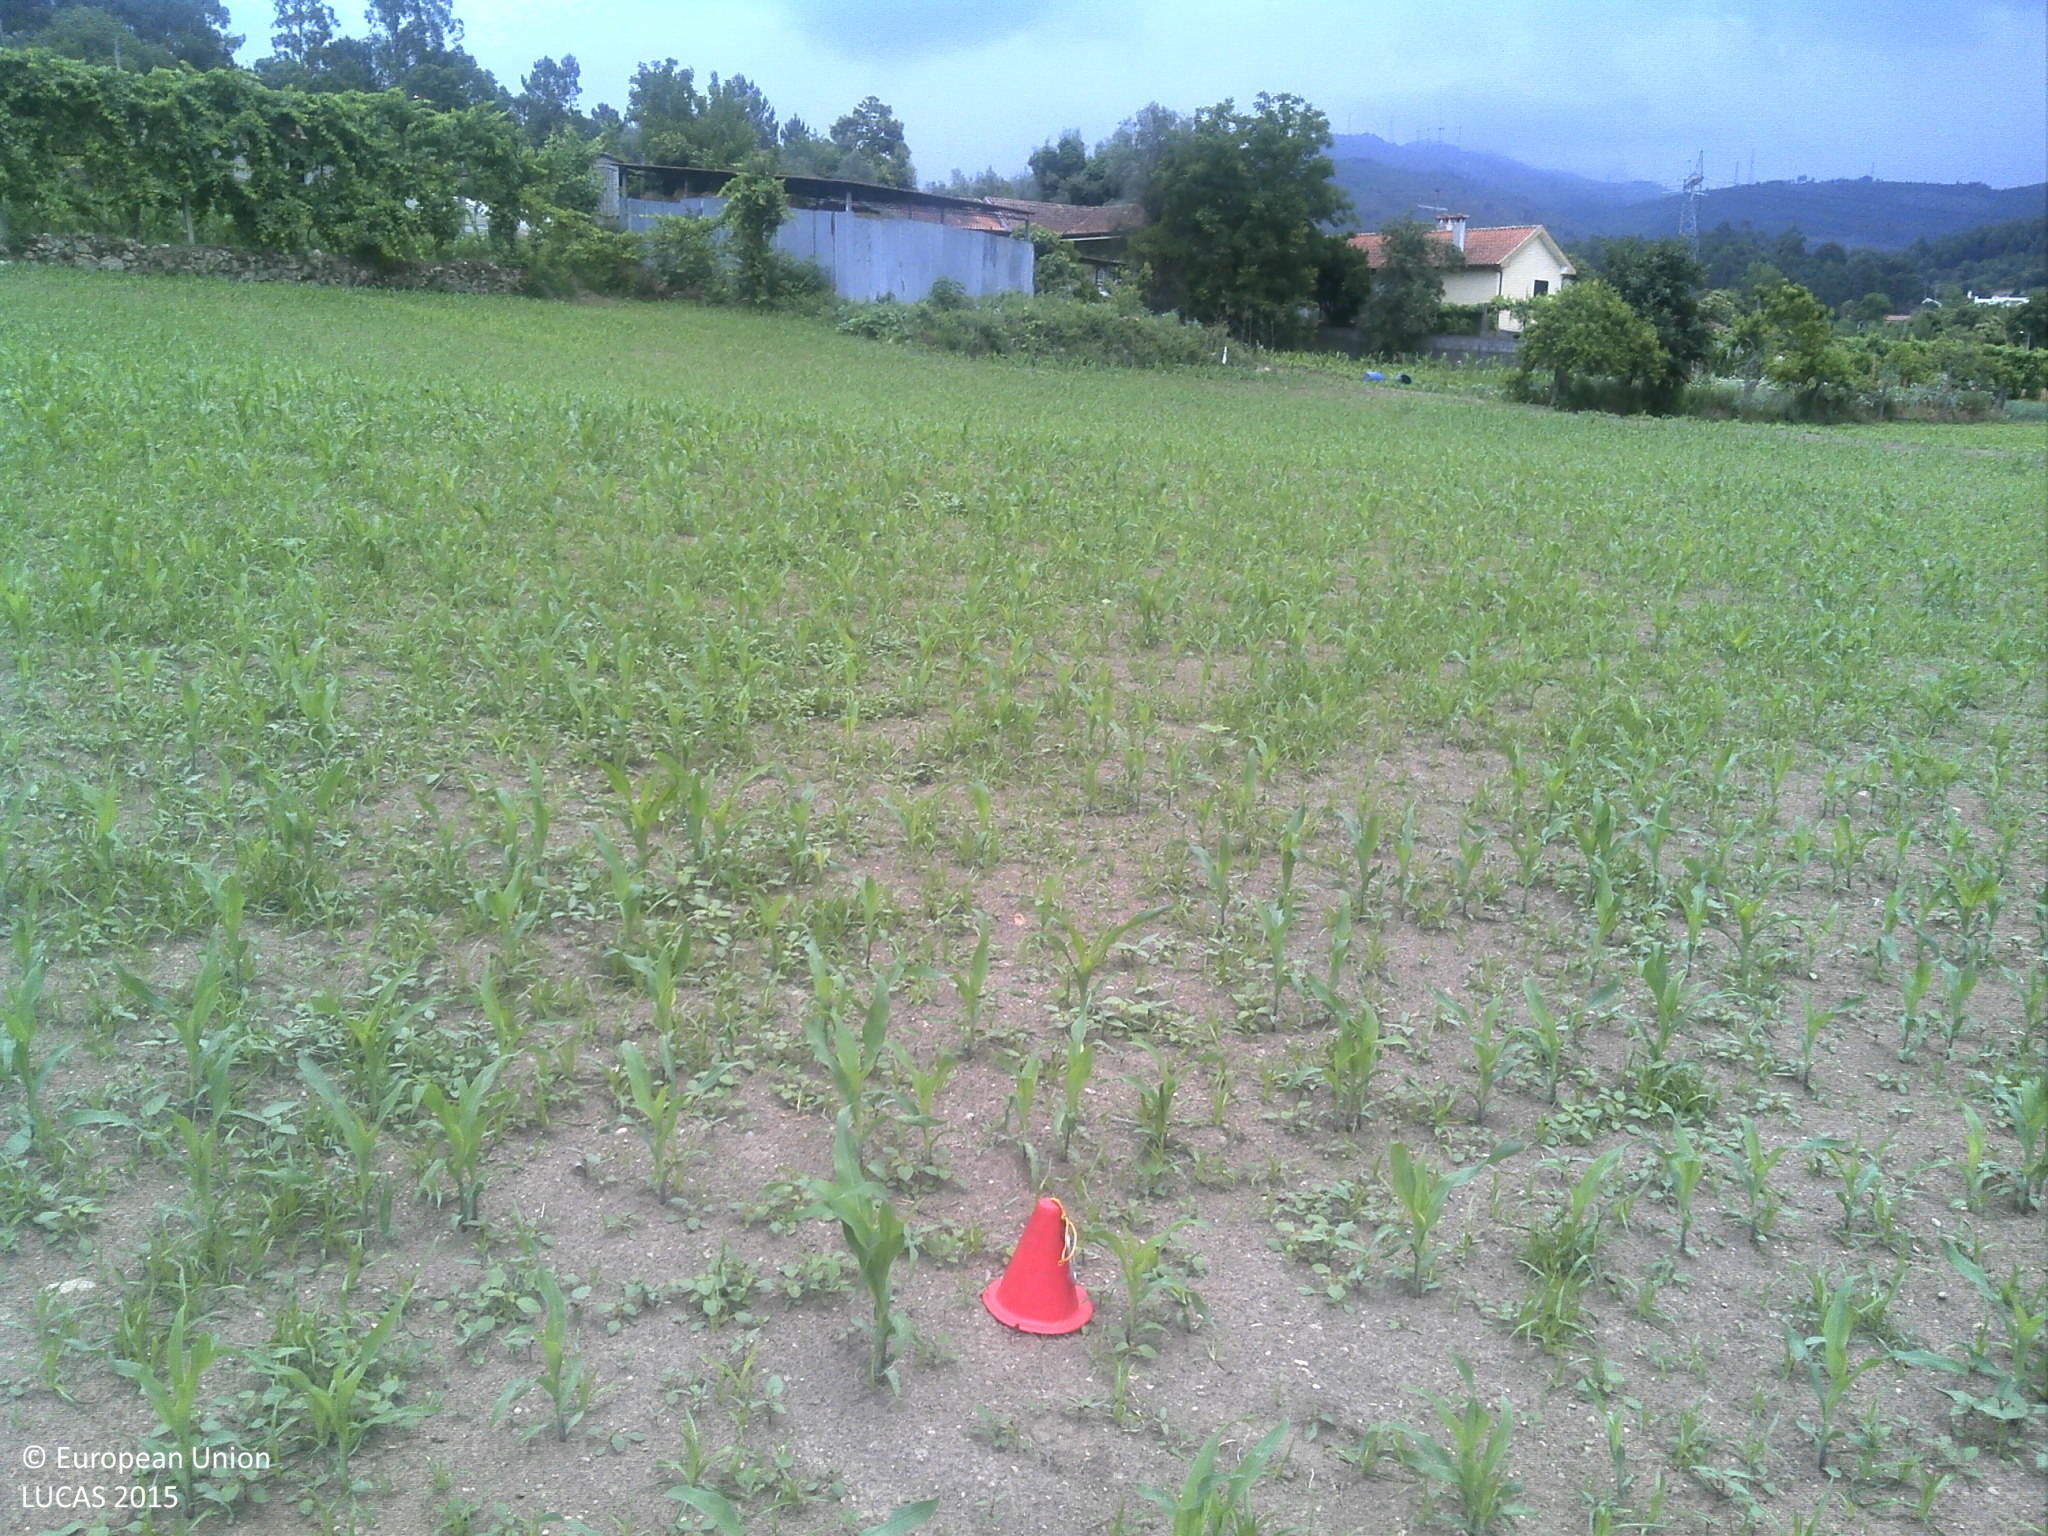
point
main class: Cropland
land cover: Maize
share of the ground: 10 - 25 %
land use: Agriculture (excluding fallow land and kitchen gardens)
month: June
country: PT
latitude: 41.6323
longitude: -8.3139
